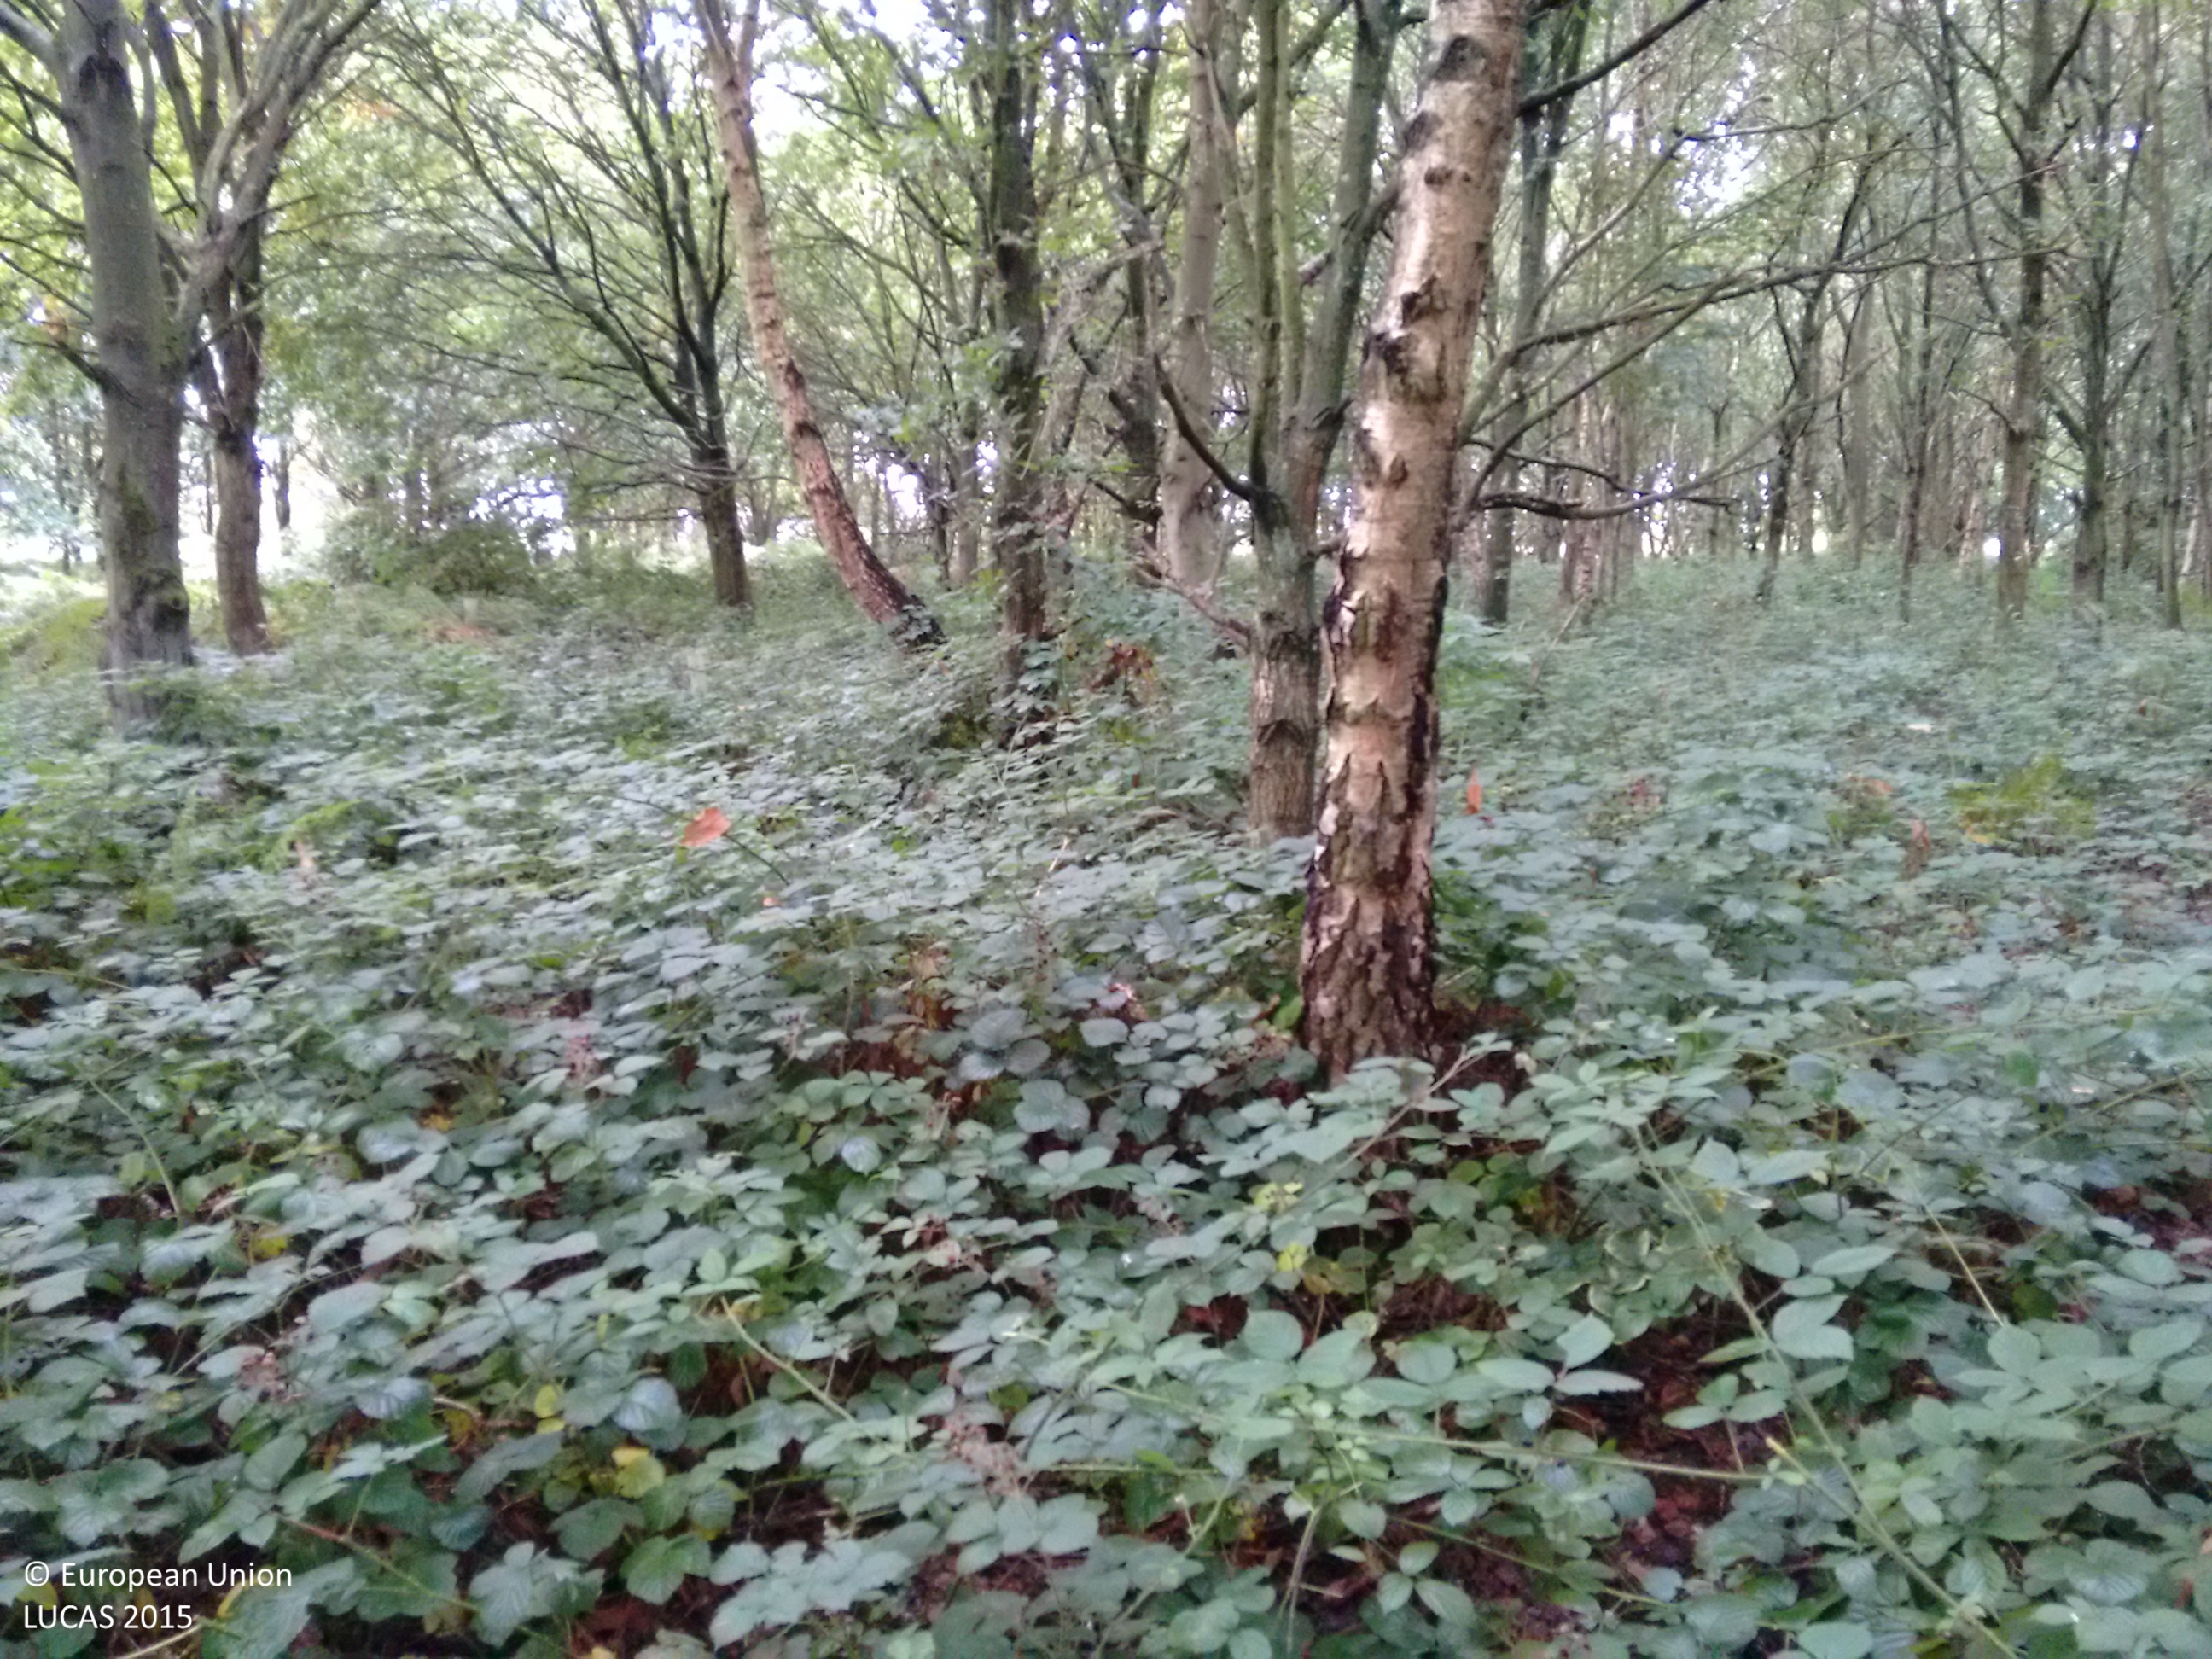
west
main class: Woodland
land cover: Broadleaved woodland
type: mesophytic deciduous forest
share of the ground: > 75 %
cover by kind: broadleaved forest trees 100 %
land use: Semi-natural and natural areas not in use
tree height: > 5 m
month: September
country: GB
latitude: 52.7928
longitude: 1.2146
